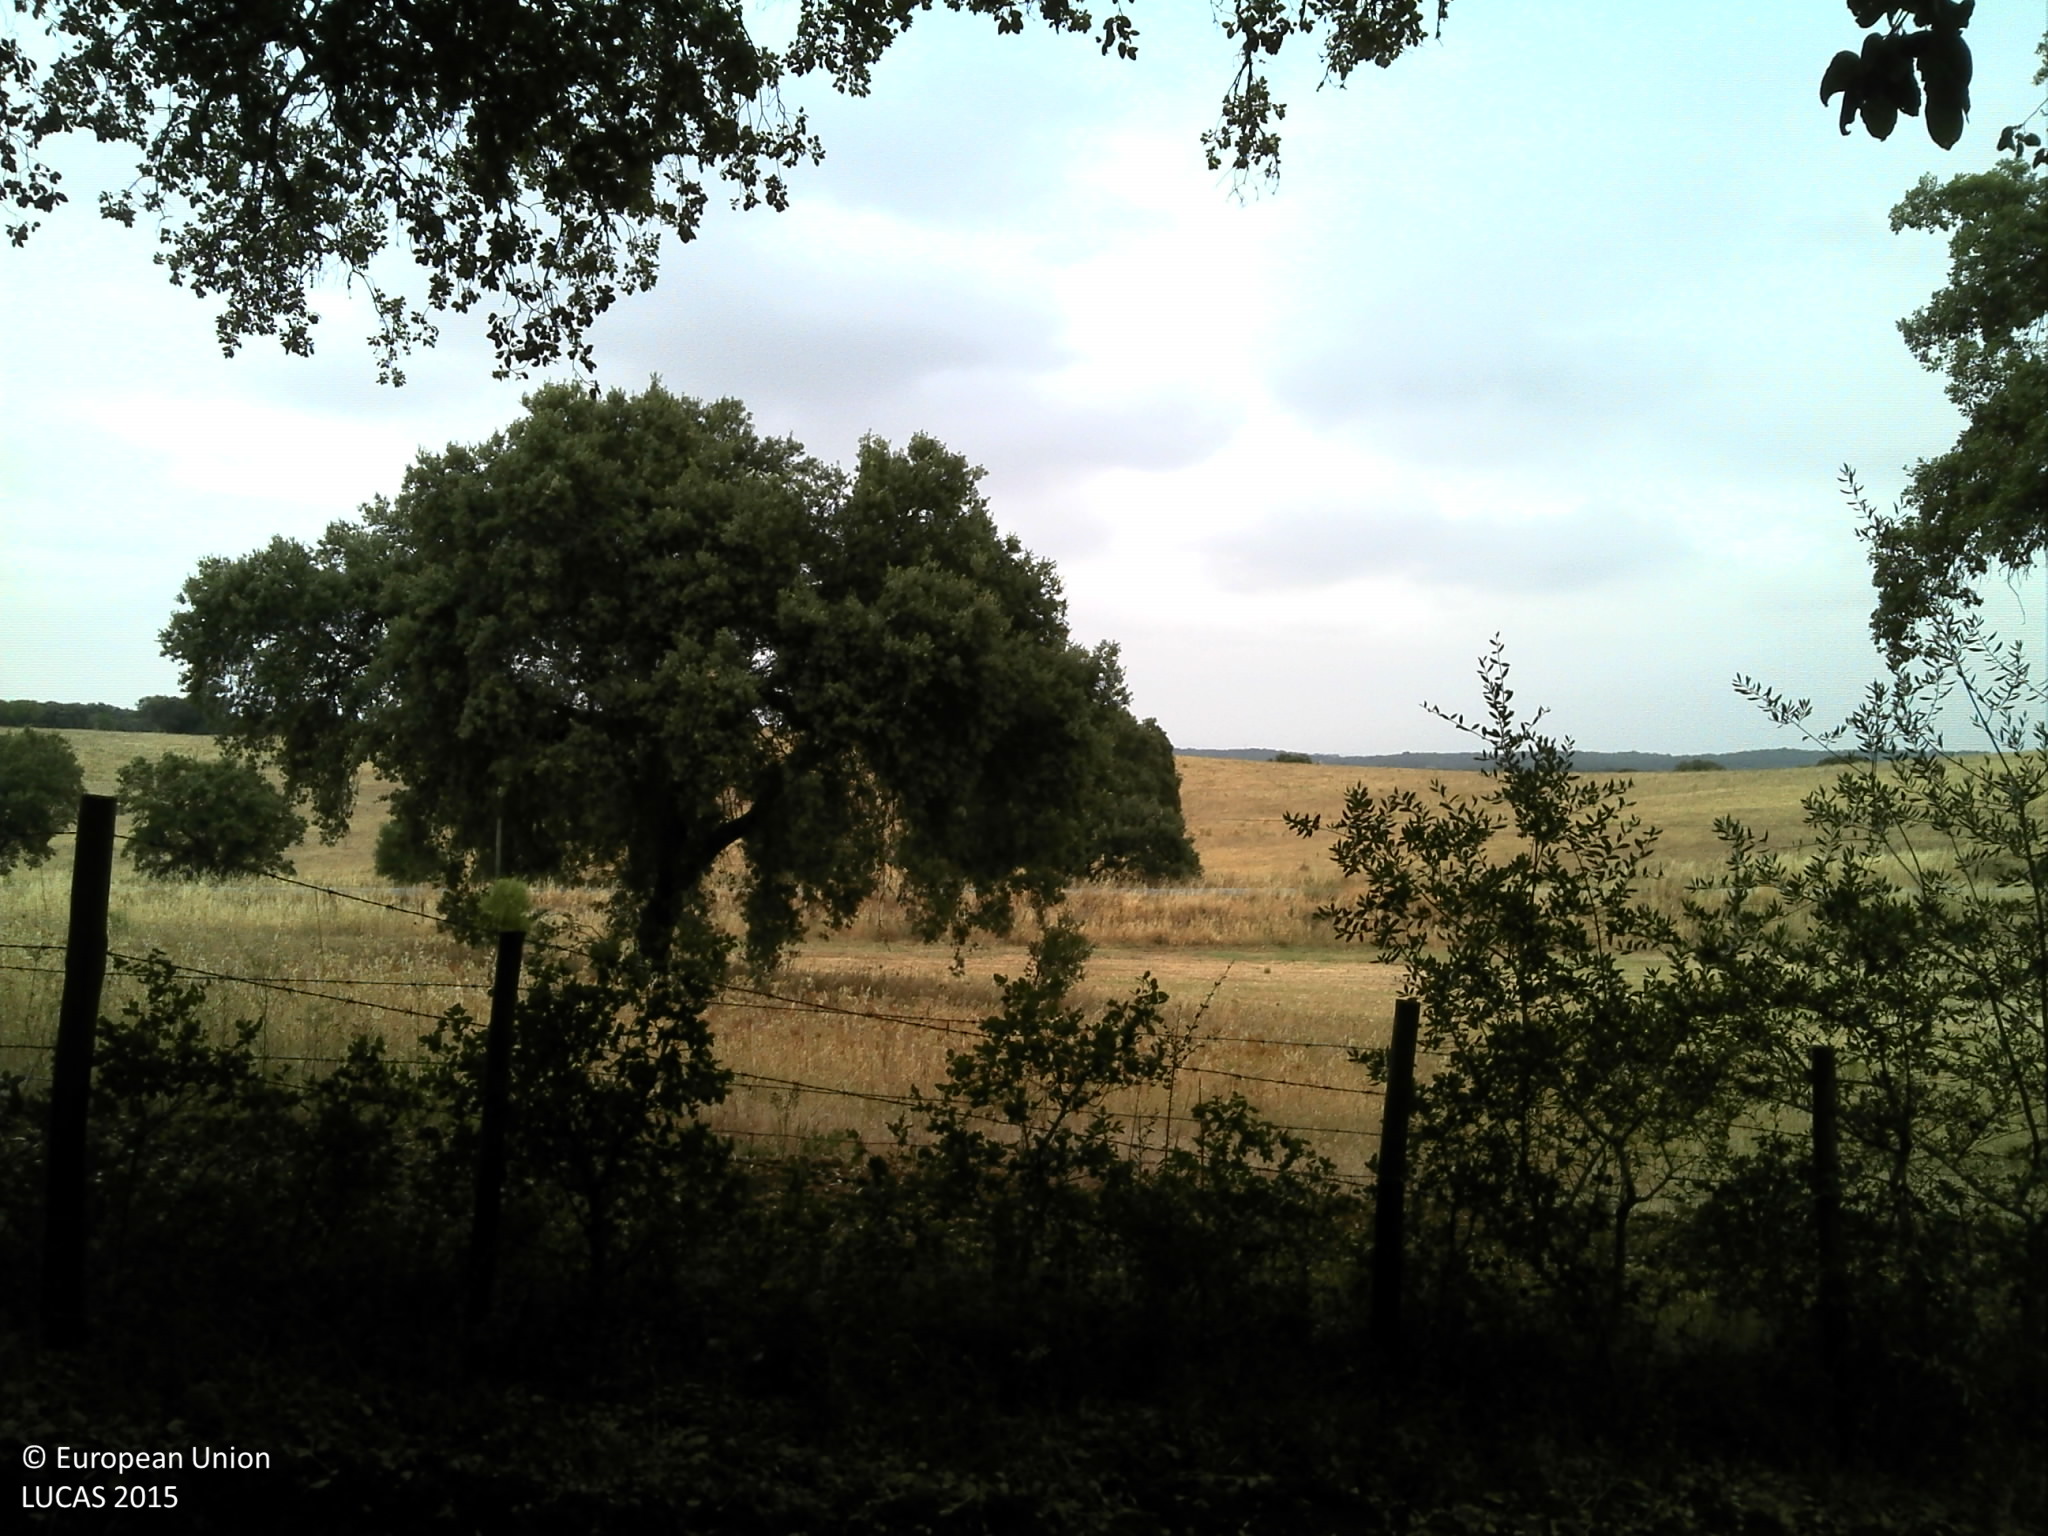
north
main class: Woodland
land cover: Broadleaved woodland
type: broadleaved evergreen forest
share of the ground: 50 - 75 %
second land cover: Grassland without tree/shrub cover
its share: 10 - 25 %
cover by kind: broadleaved forest trees 75 %, herbaceous plants 15 %, unconsolidated bare surface 10 %
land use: Forestry
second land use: Agriculture (excluding fallow land and kitchen gardens)
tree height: > 5 m
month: June
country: PT
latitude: 38.3569
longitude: -7.9458
